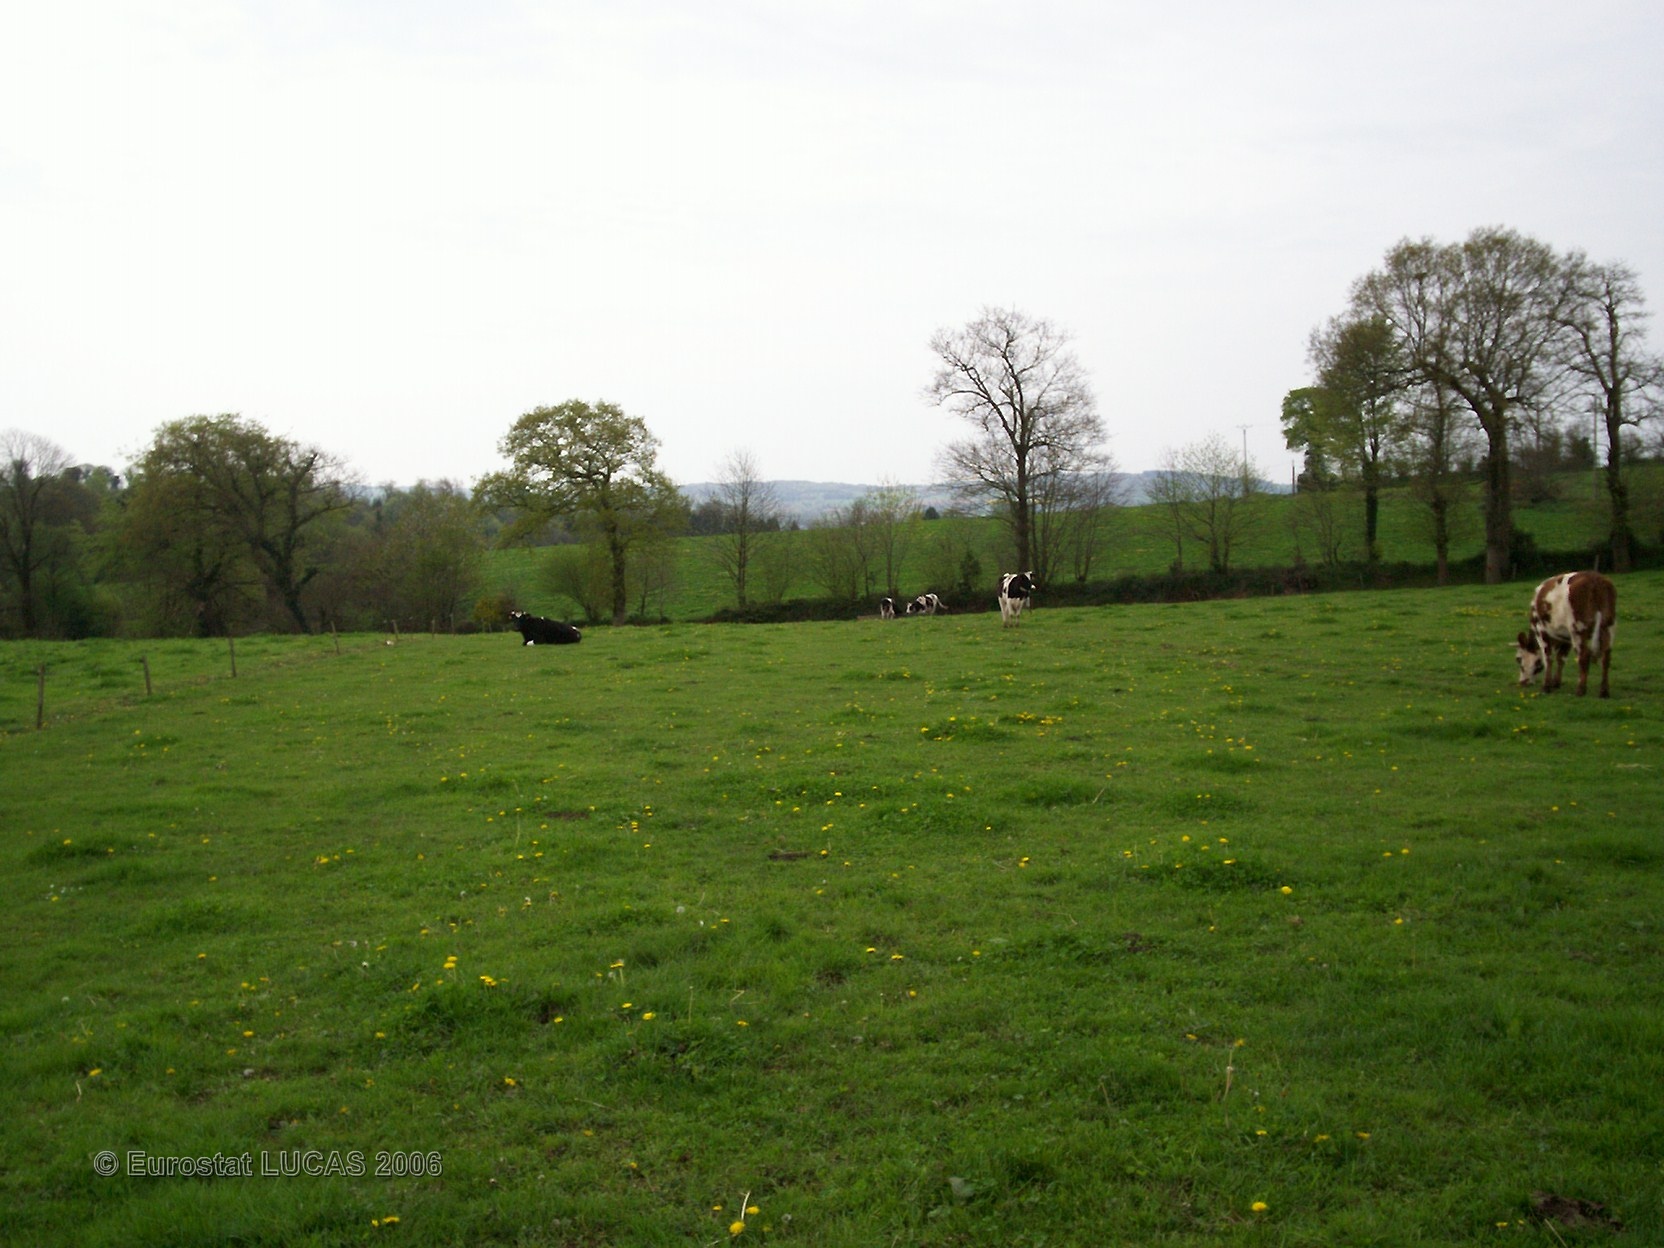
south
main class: Grassland
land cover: Grassland without tree/shrub cover
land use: Agriculture (excluding fallow land and kitchen gardens)
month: May
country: FR
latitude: 48.2063
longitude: -3.9598
